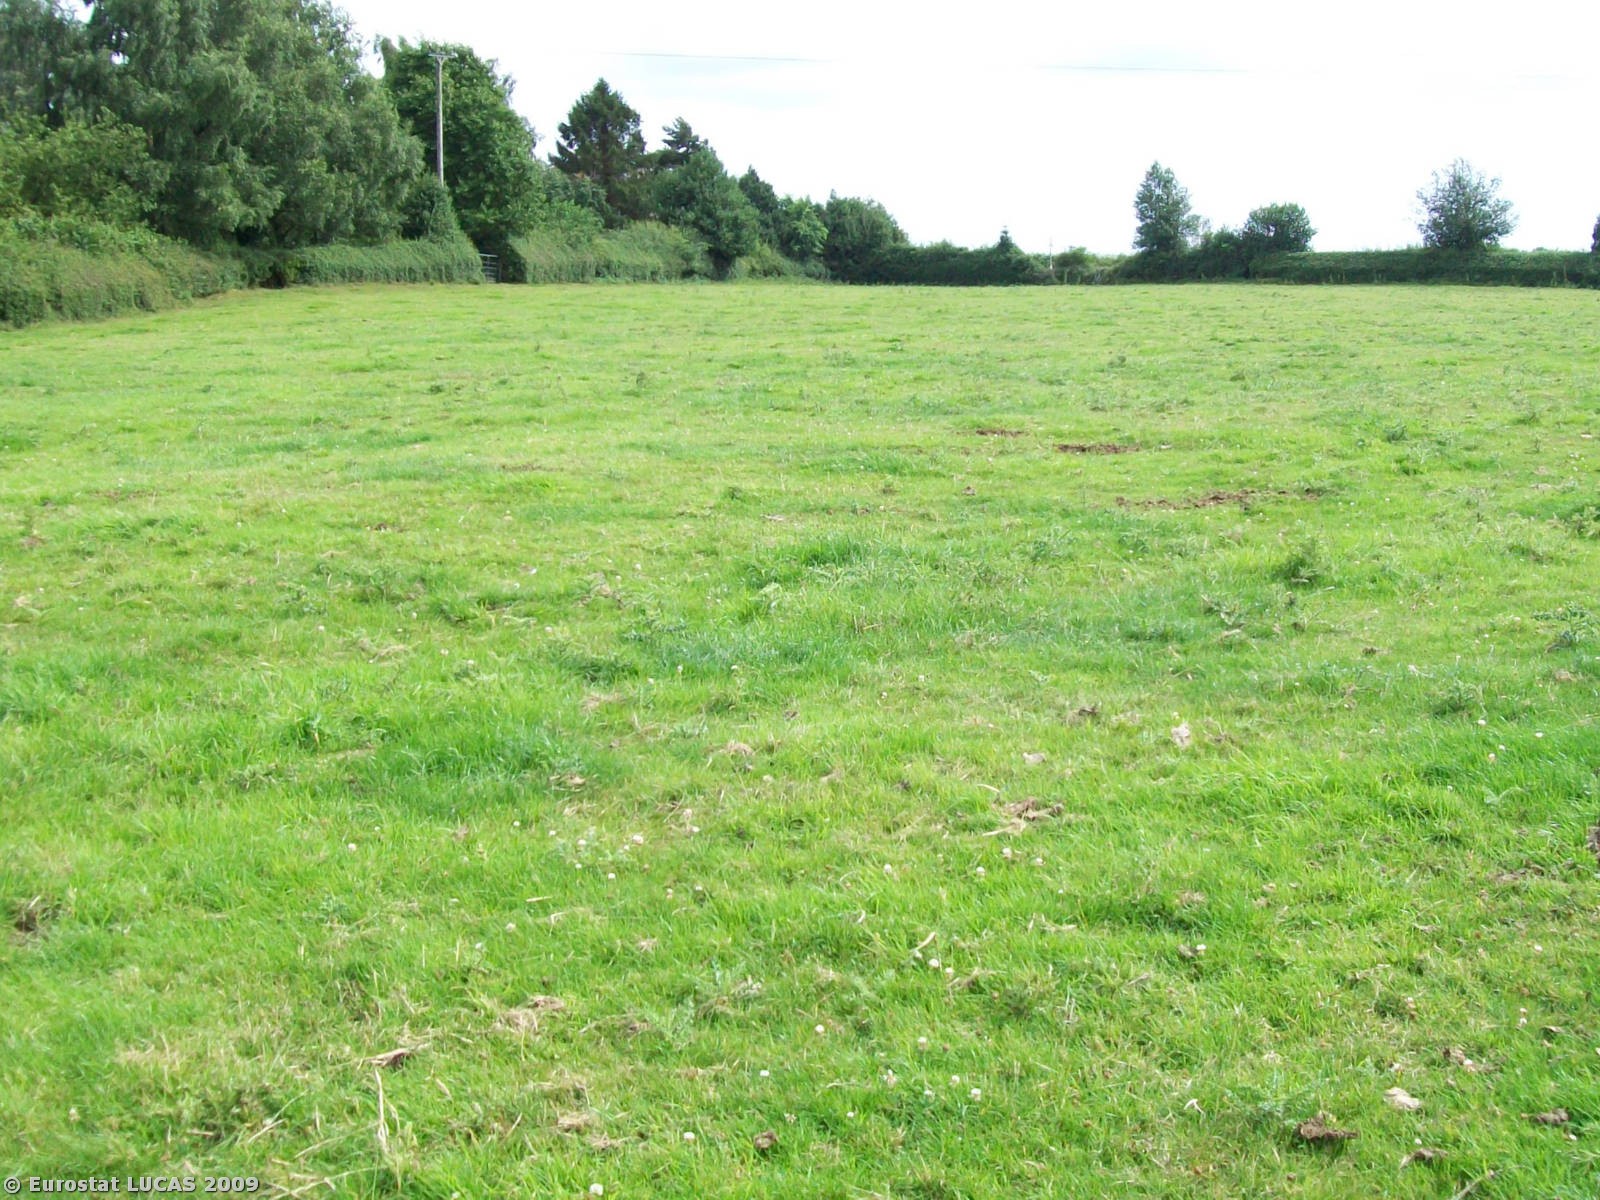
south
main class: Grassland
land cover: Grassland without tree/shrub cover
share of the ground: > 75 %
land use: Agriculture (excluding fallow land and kitchen gardens)
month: July
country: GB
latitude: 52.6273
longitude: -1.3805
